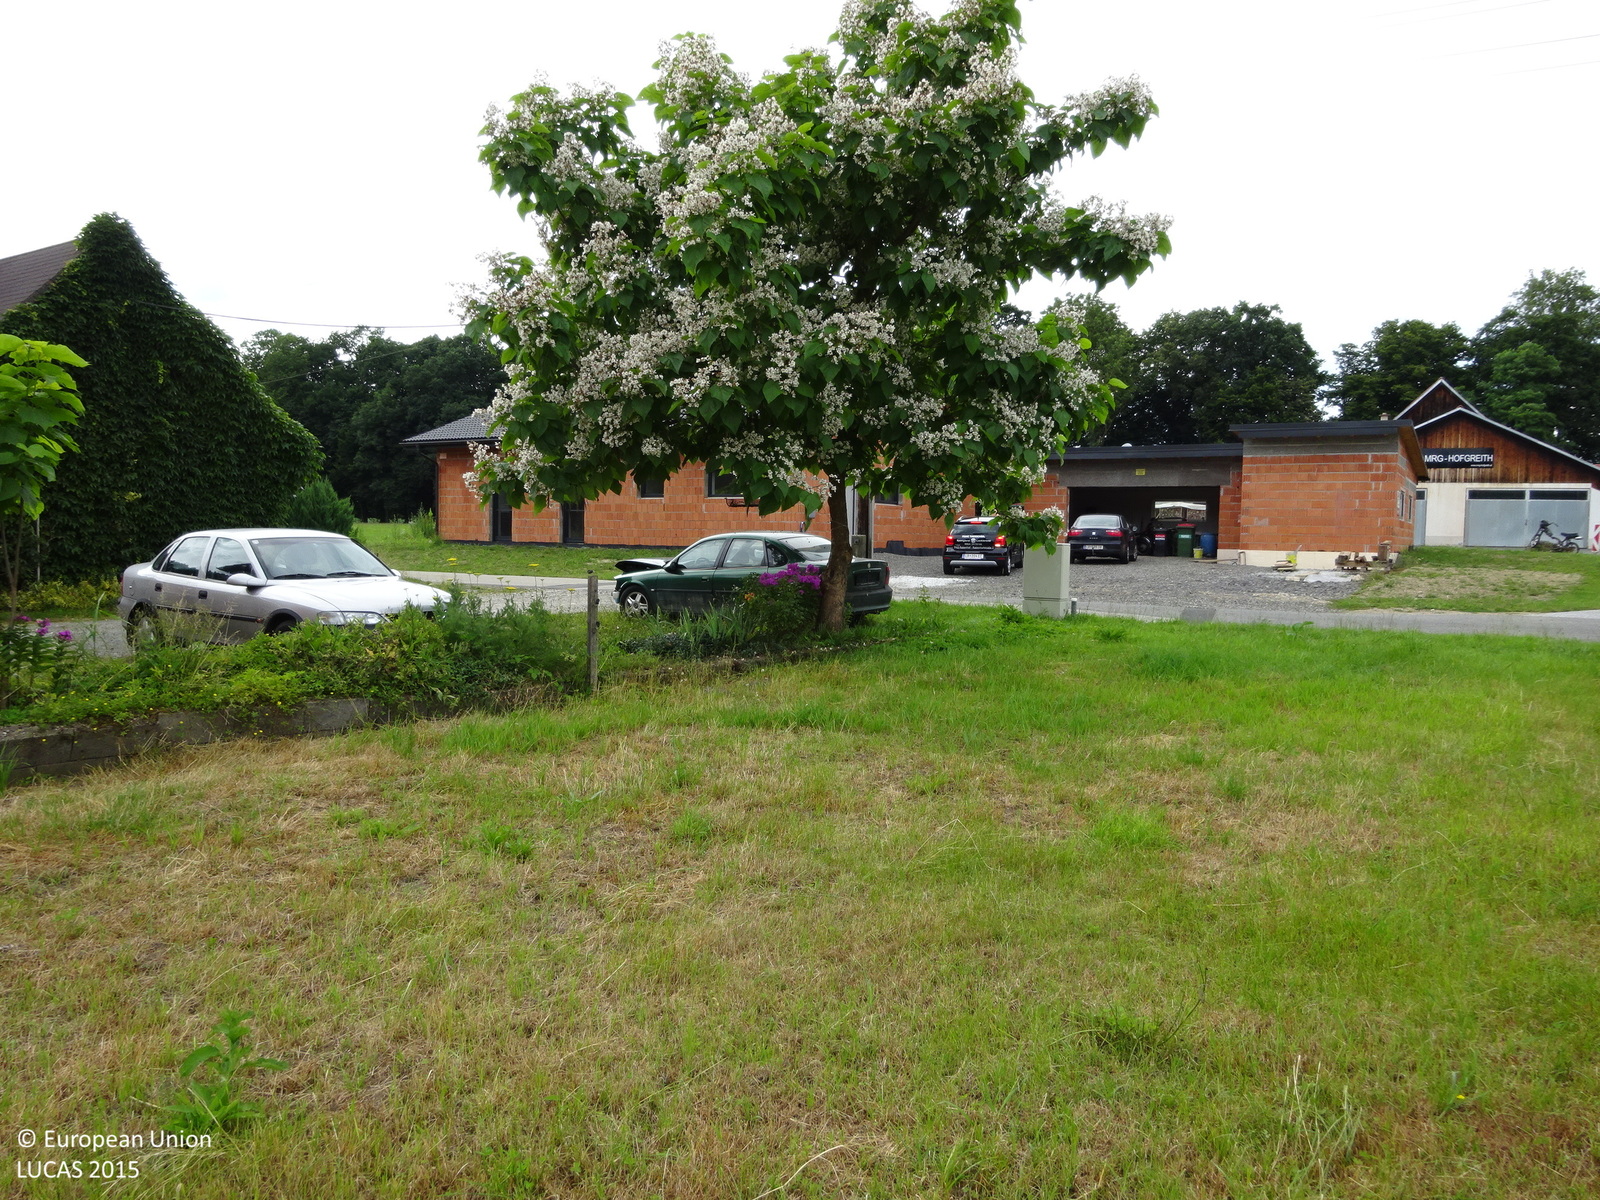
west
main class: Grassland
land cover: Grassland without tree/shrub cover
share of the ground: > 75 %
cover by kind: herbaceous plants 100 %
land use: Agriculture (excluding fallow land and kitchen gardens)
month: June
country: AT
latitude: 46.7273
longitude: 15.6128
